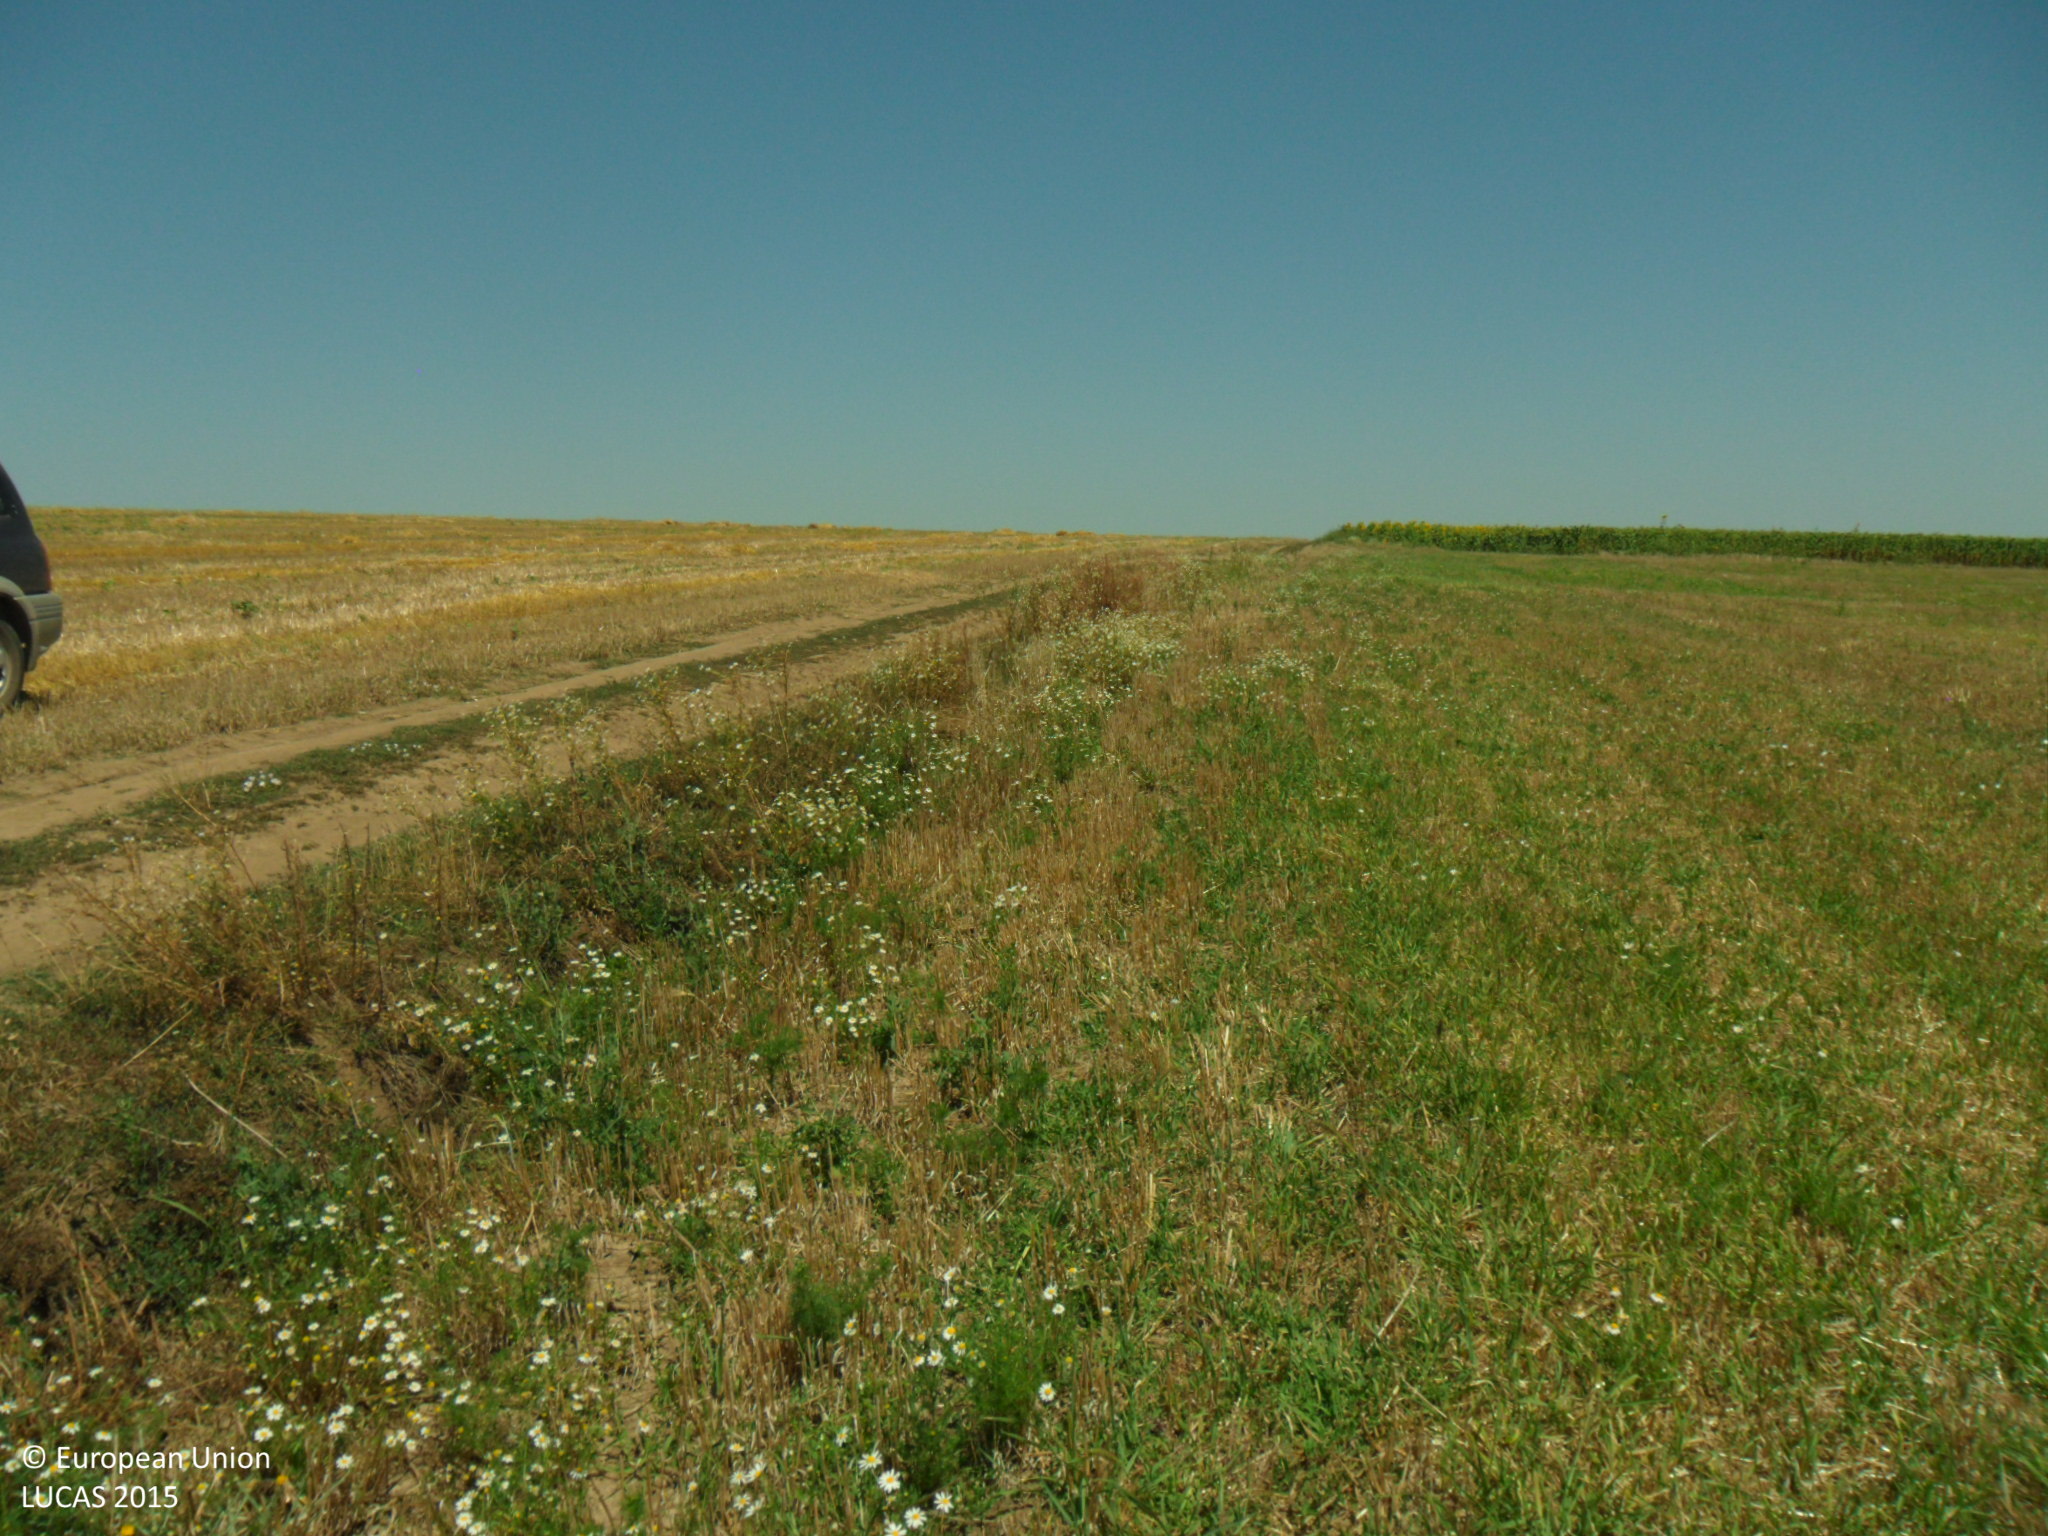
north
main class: Cropland
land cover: Common wheat
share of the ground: > 75 %
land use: Agriculture (excluding fallow land and kitchen gardens)
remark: Harvested field
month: July
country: BG
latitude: 43.7889
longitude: 26.3970
